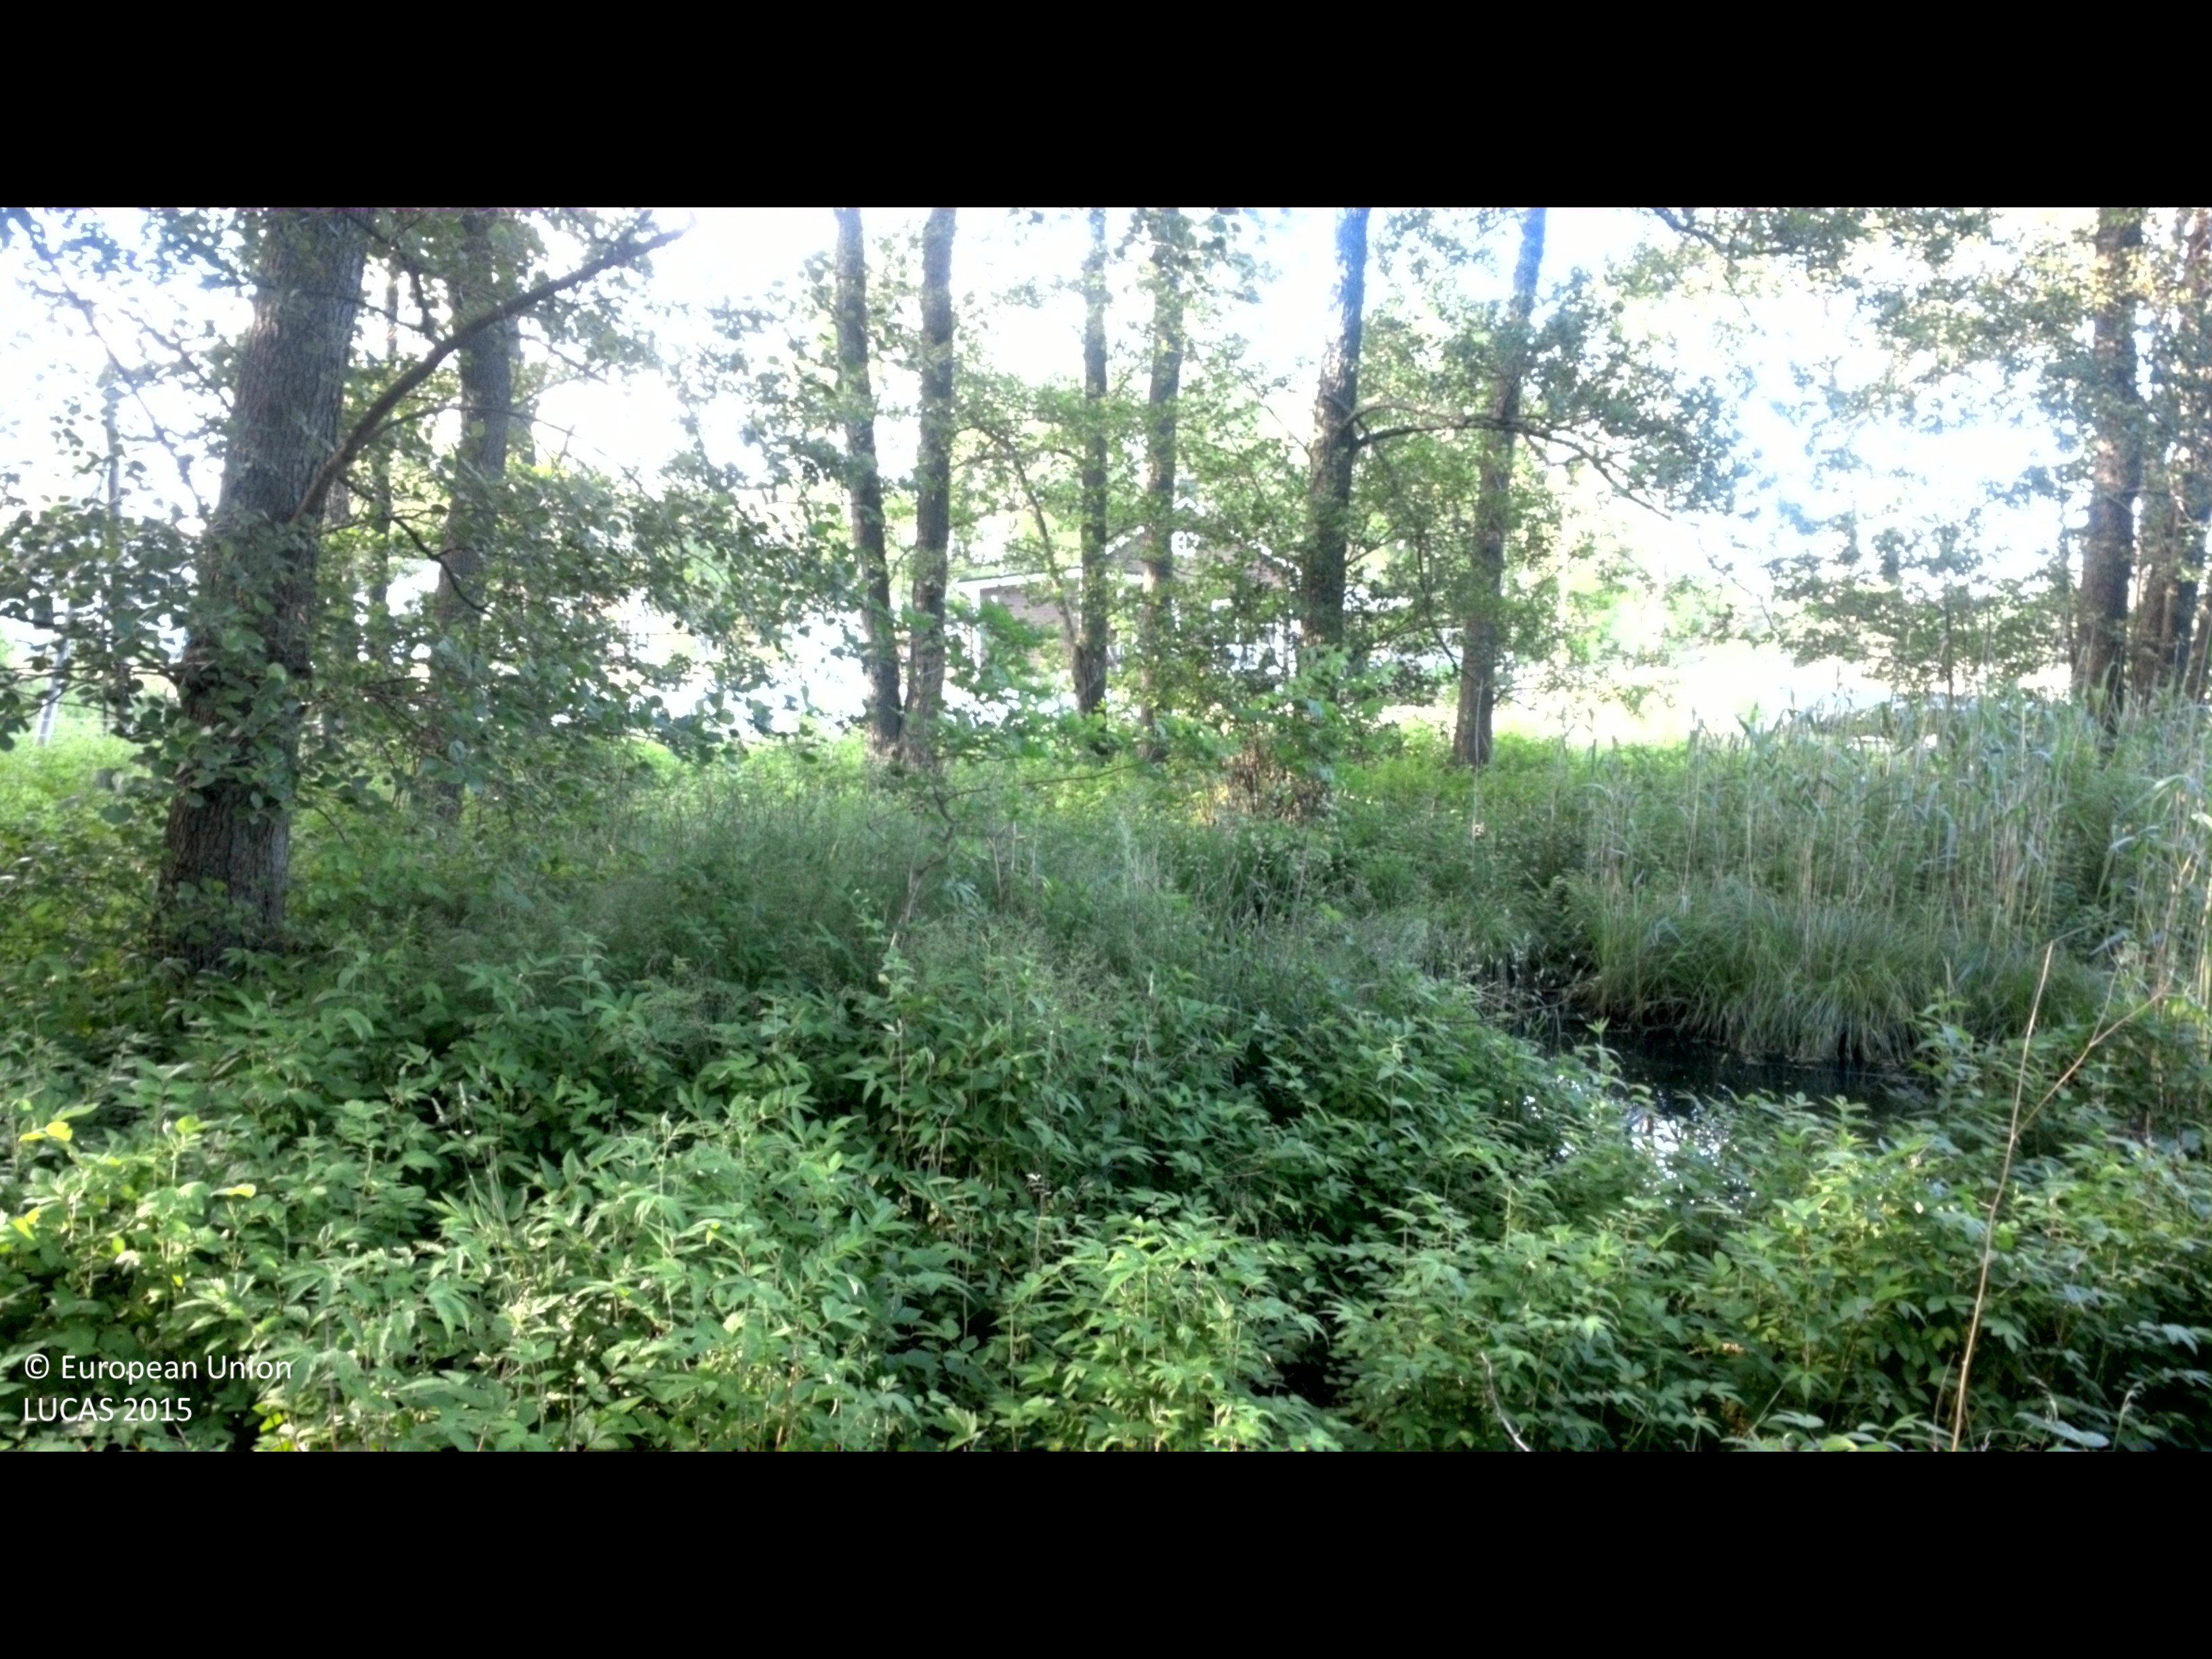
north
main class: Woodland
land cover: Broadleaved woodland
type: hemiboreal forest and nemoral coniferous forest and mixed broadleaved-coniferous forest
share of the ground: > 75 %
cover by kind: broadleaved forest trees 75 %, herbaceous plants 20 %, shrubs 5 %
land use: Forestry
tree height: > 5 m
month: June
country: SE
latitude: 57.7649
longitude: 16.6722
